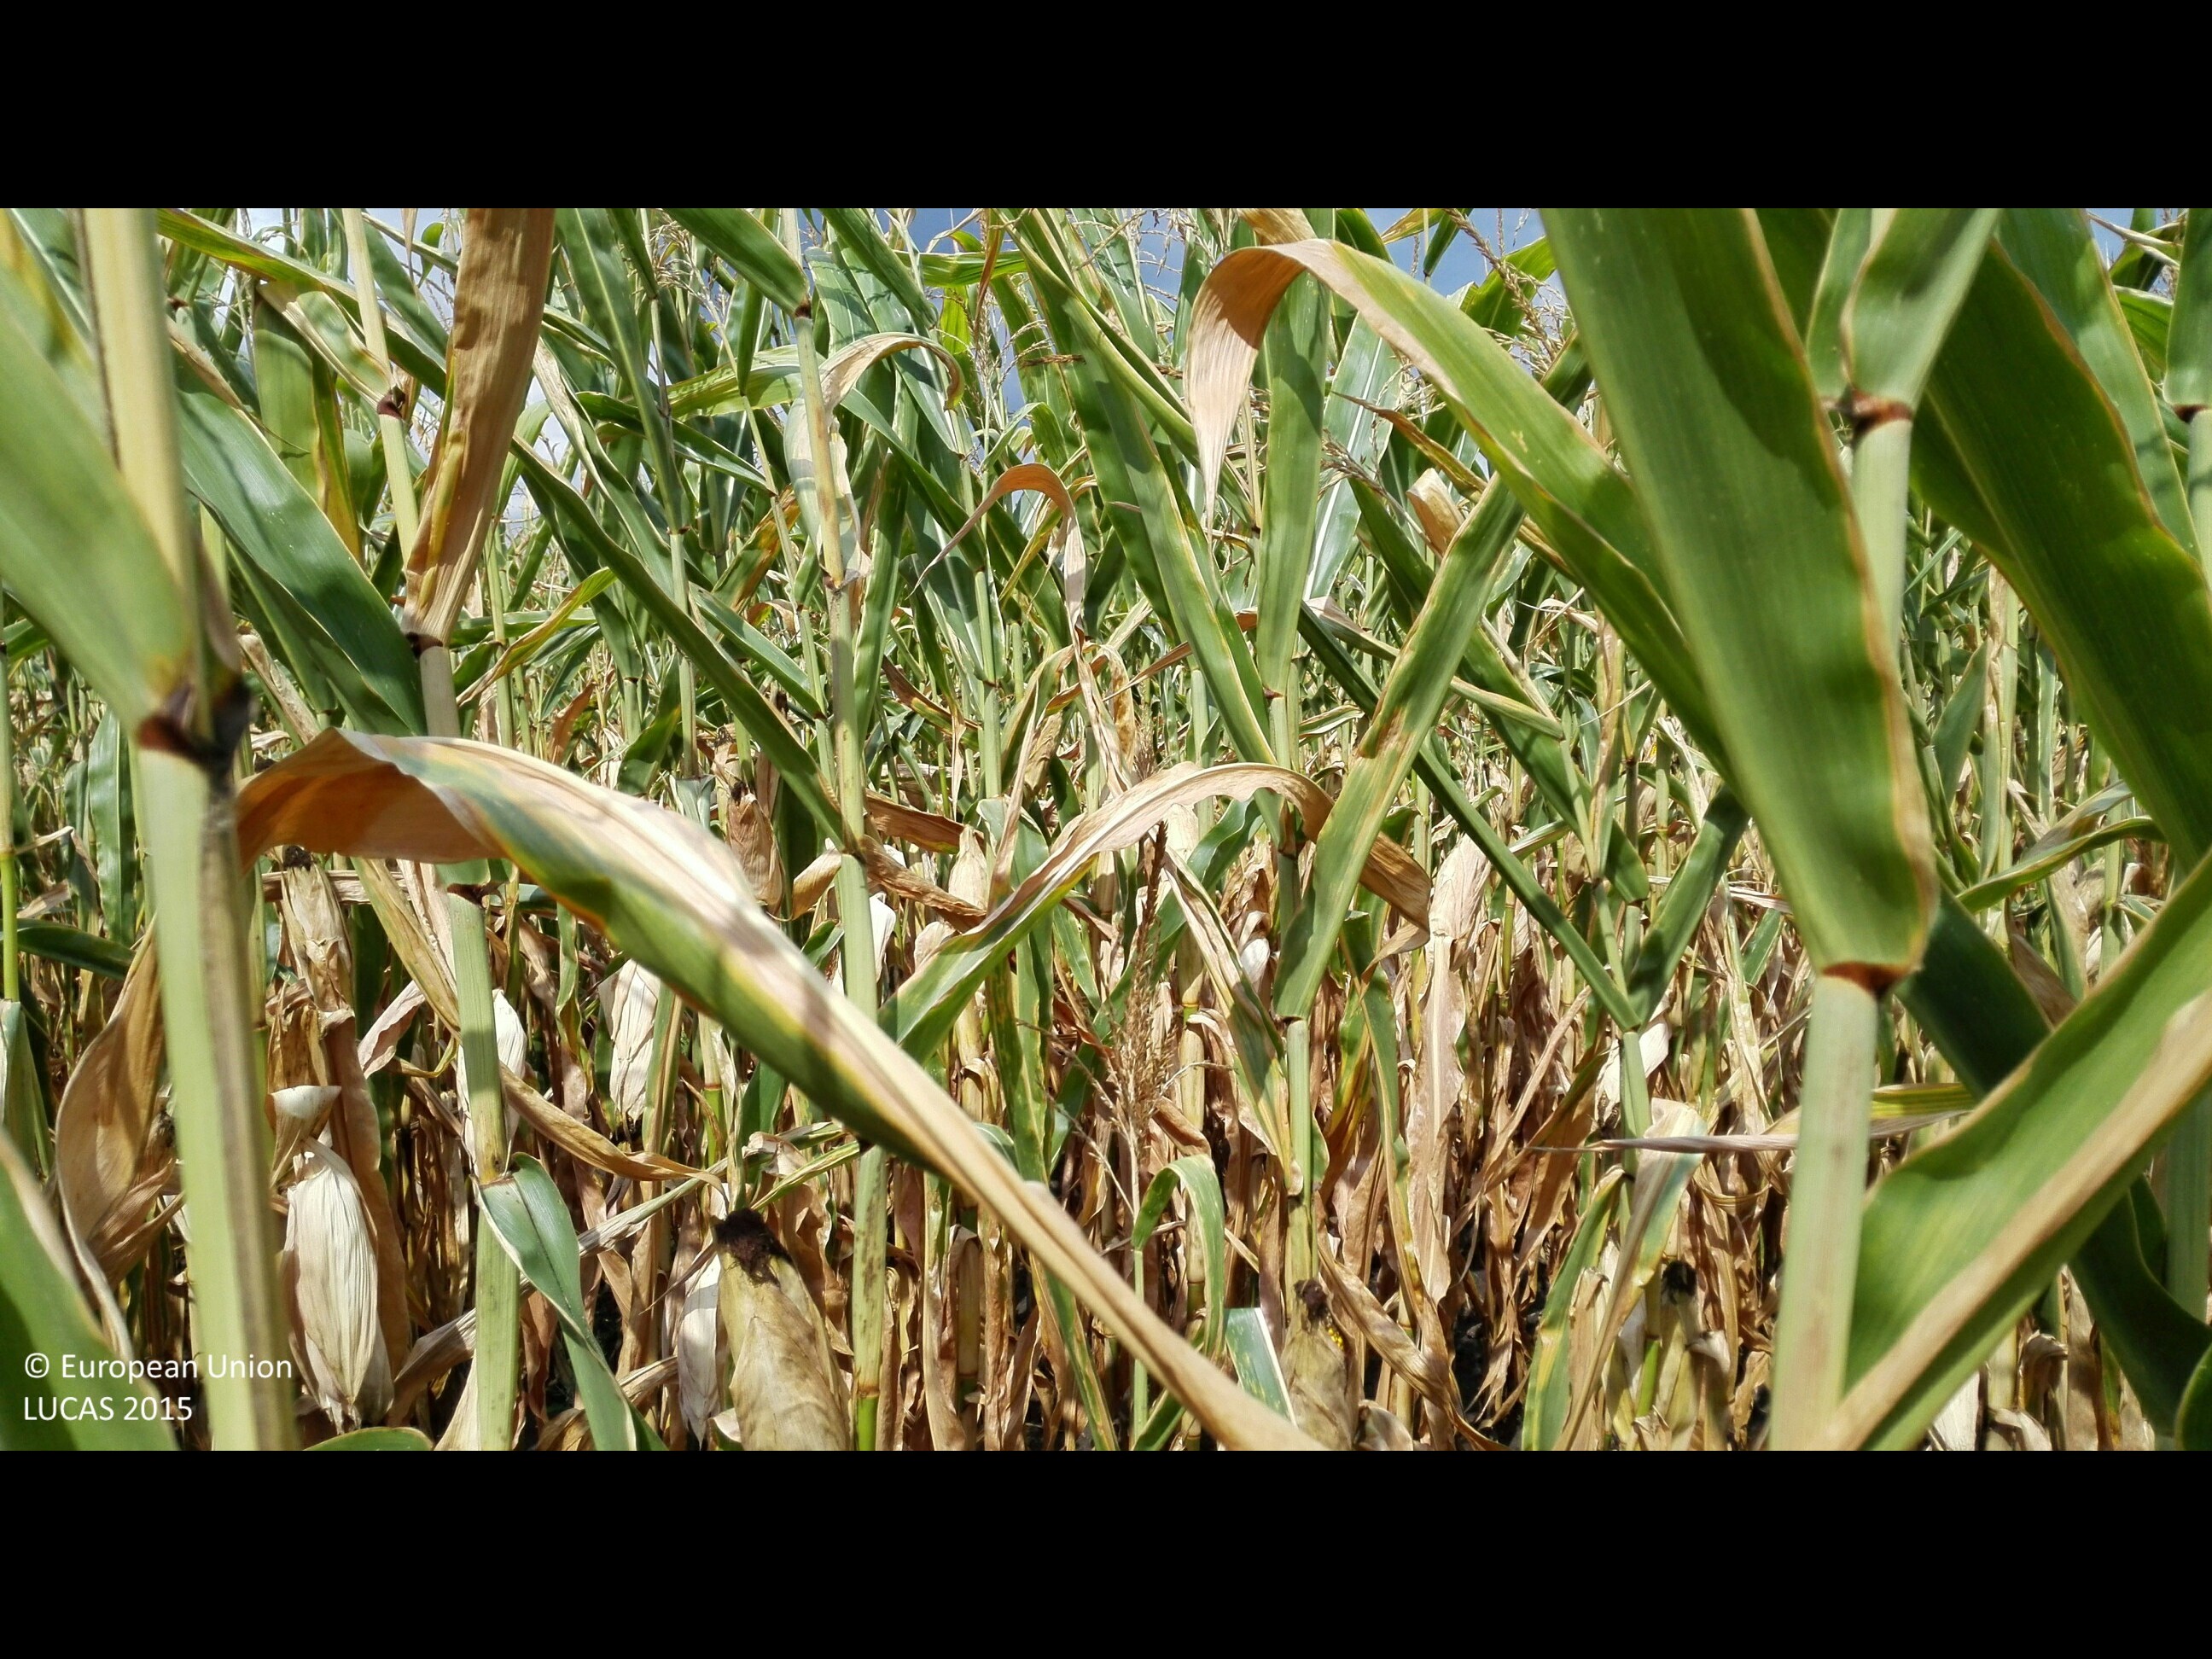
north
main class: Cropland
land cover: Maize
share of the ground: > 75 %
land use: Agriculture (excluding fallow land and kitchen gardens)
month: August
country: HU
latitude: 47.3692
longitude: 21.6310
